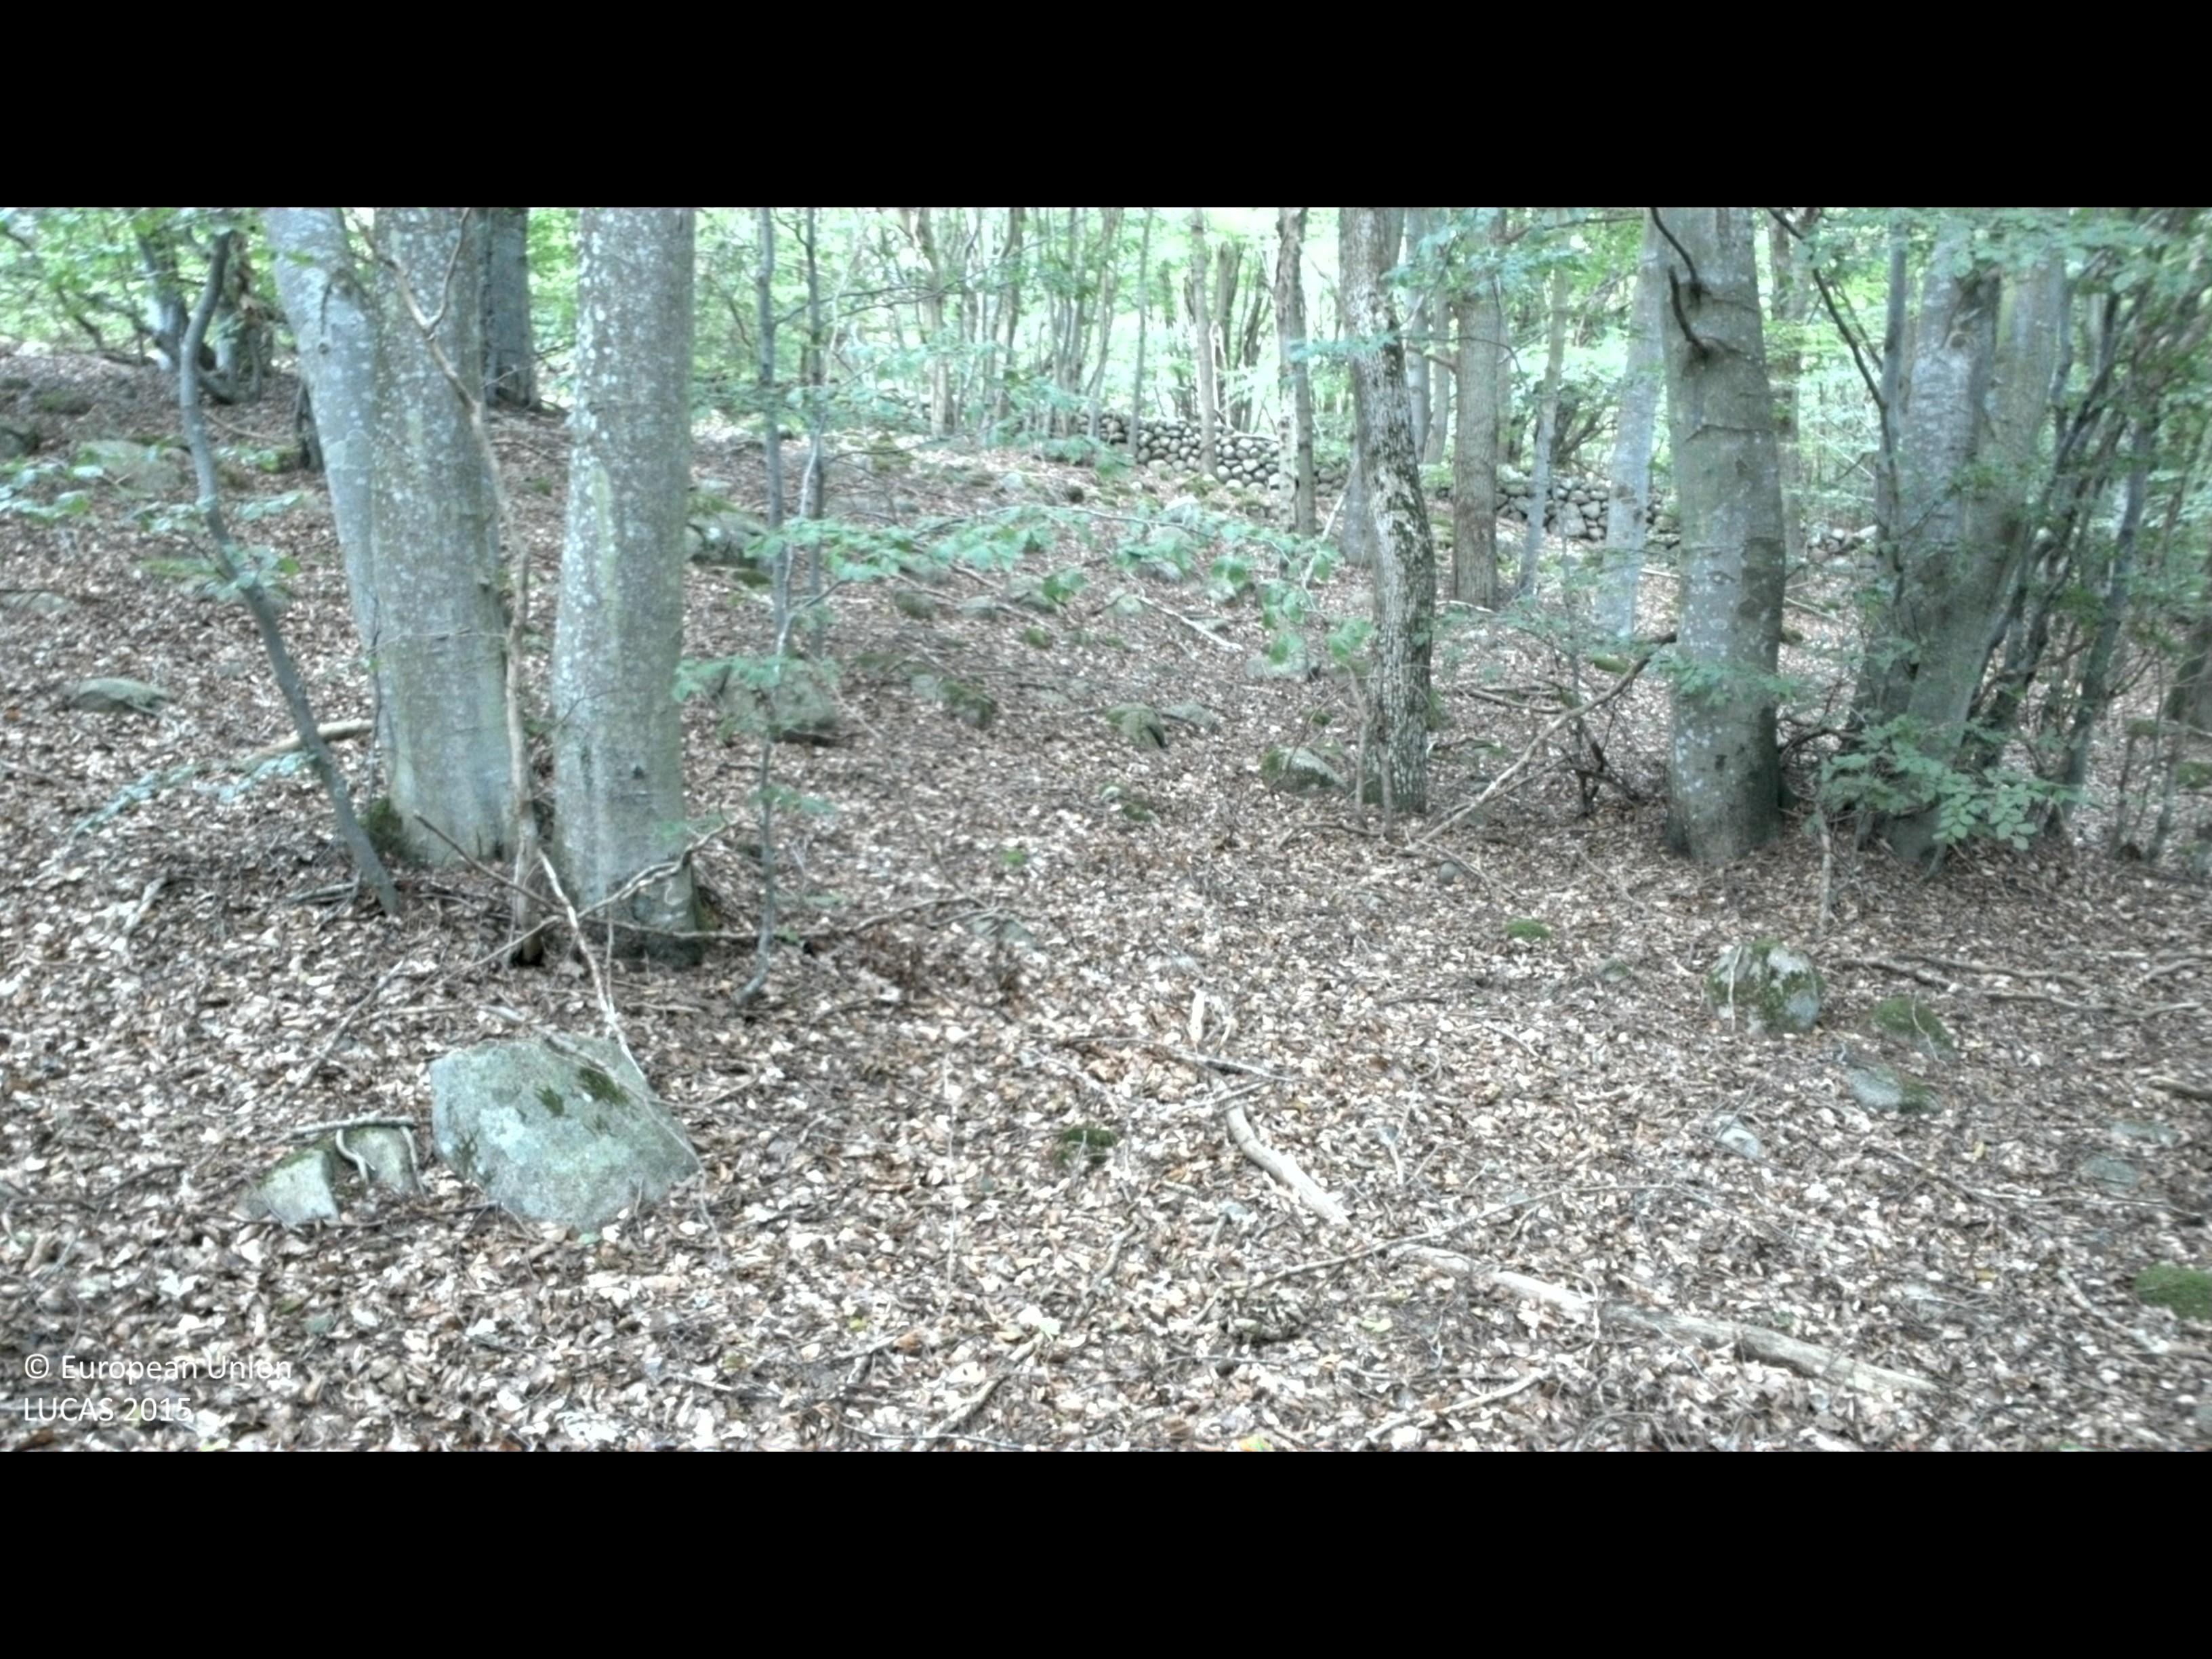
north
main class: Woodland
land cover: Broadleaved woodland
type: beech forest
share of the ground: > 75 %
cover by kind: broadleaved forest trees 75 %, consolidated bare surface 5 %
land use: Amenities, museums, leisure
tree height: > 5 m
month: September
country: SE
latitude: 56.0273
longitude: 14.7643
